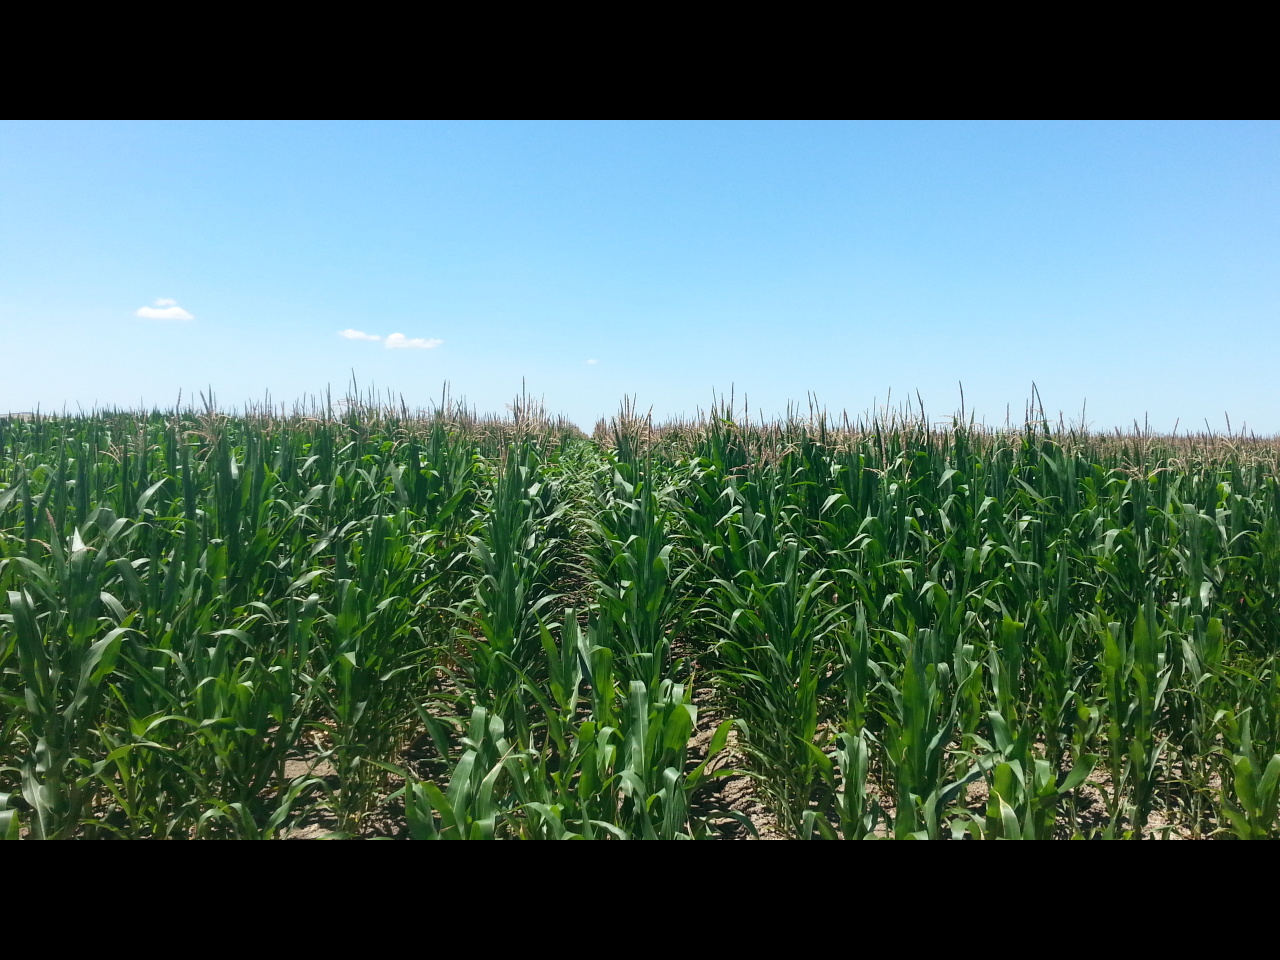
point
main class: Cropland
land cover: Maize
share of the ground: > 75 %
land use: Agriculture (excluding fallow land and kitchen gardens)
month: June
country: ES
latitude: 36.9835
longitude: -6.0485
